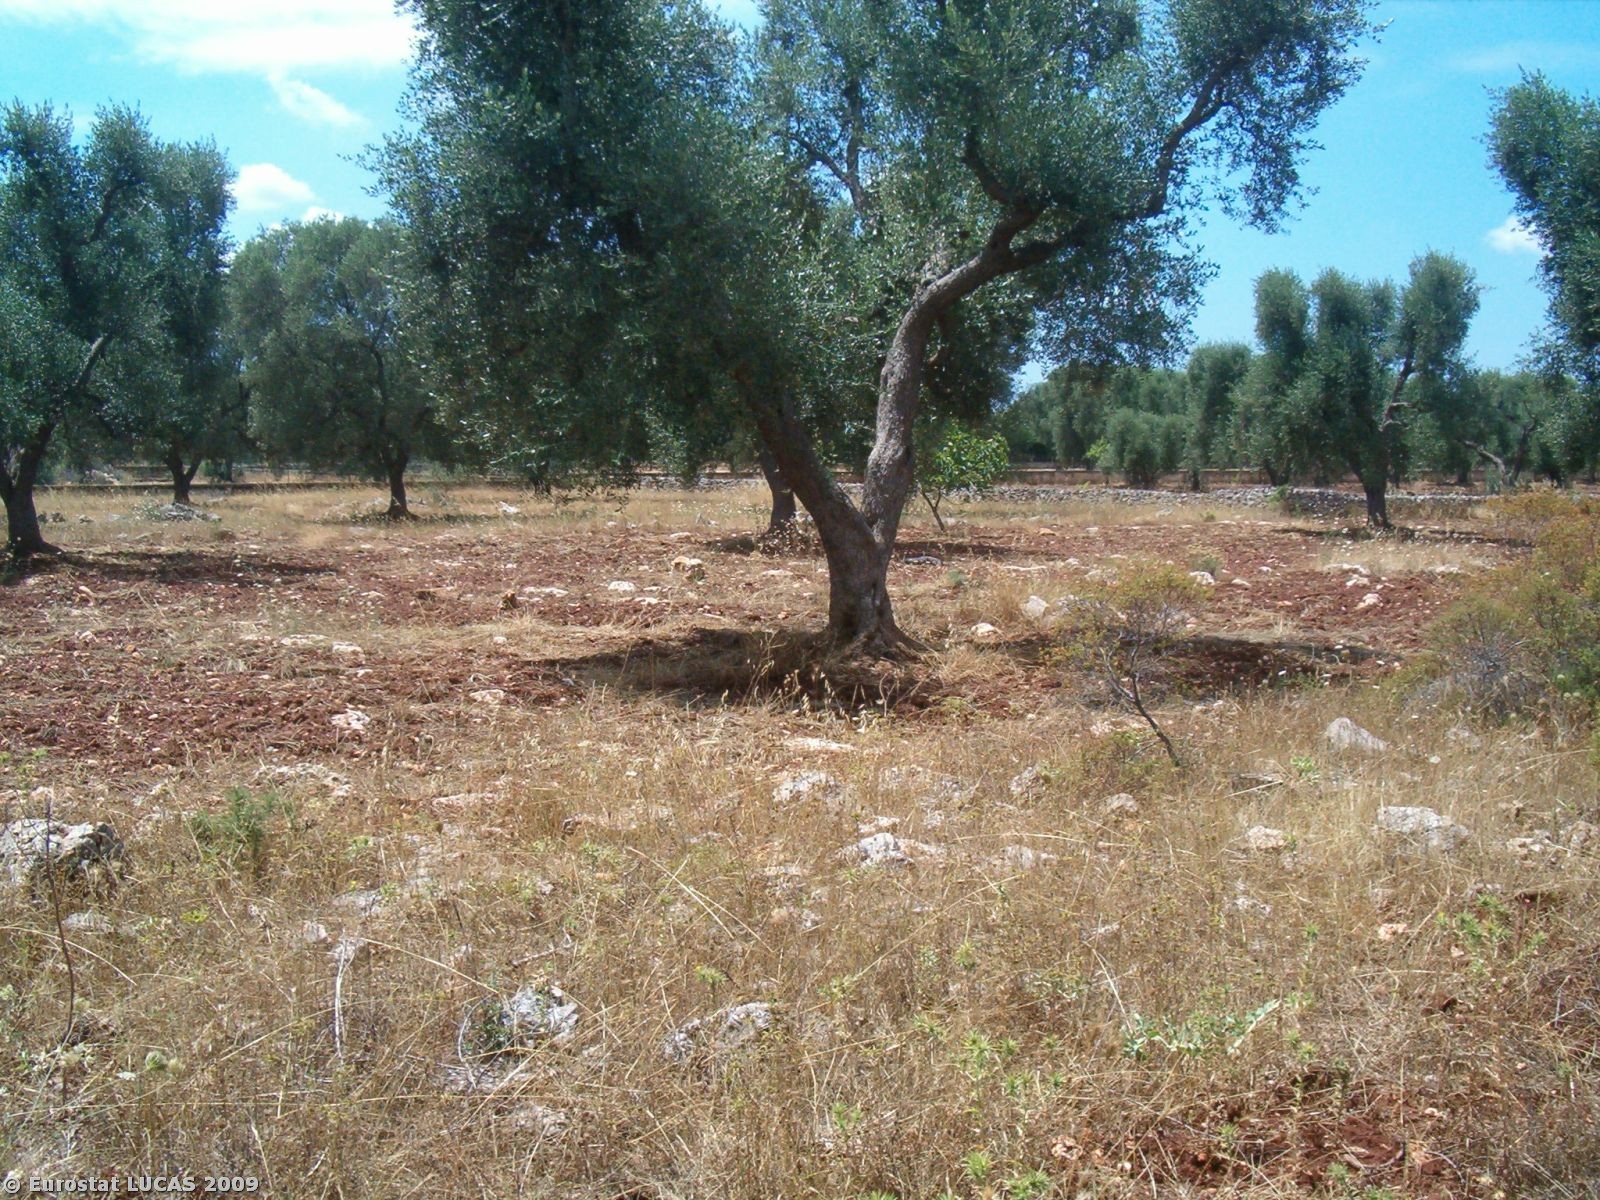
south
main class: Cropland
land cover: Olive groves
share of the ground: 50 - 75 %
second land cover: Spontaneously vegetated surfaces
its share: > 75 %
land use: Agriculture (excluding fallow land and kitchen gardens)
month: June
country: IT
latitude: 40.5037
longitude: 17.5399
